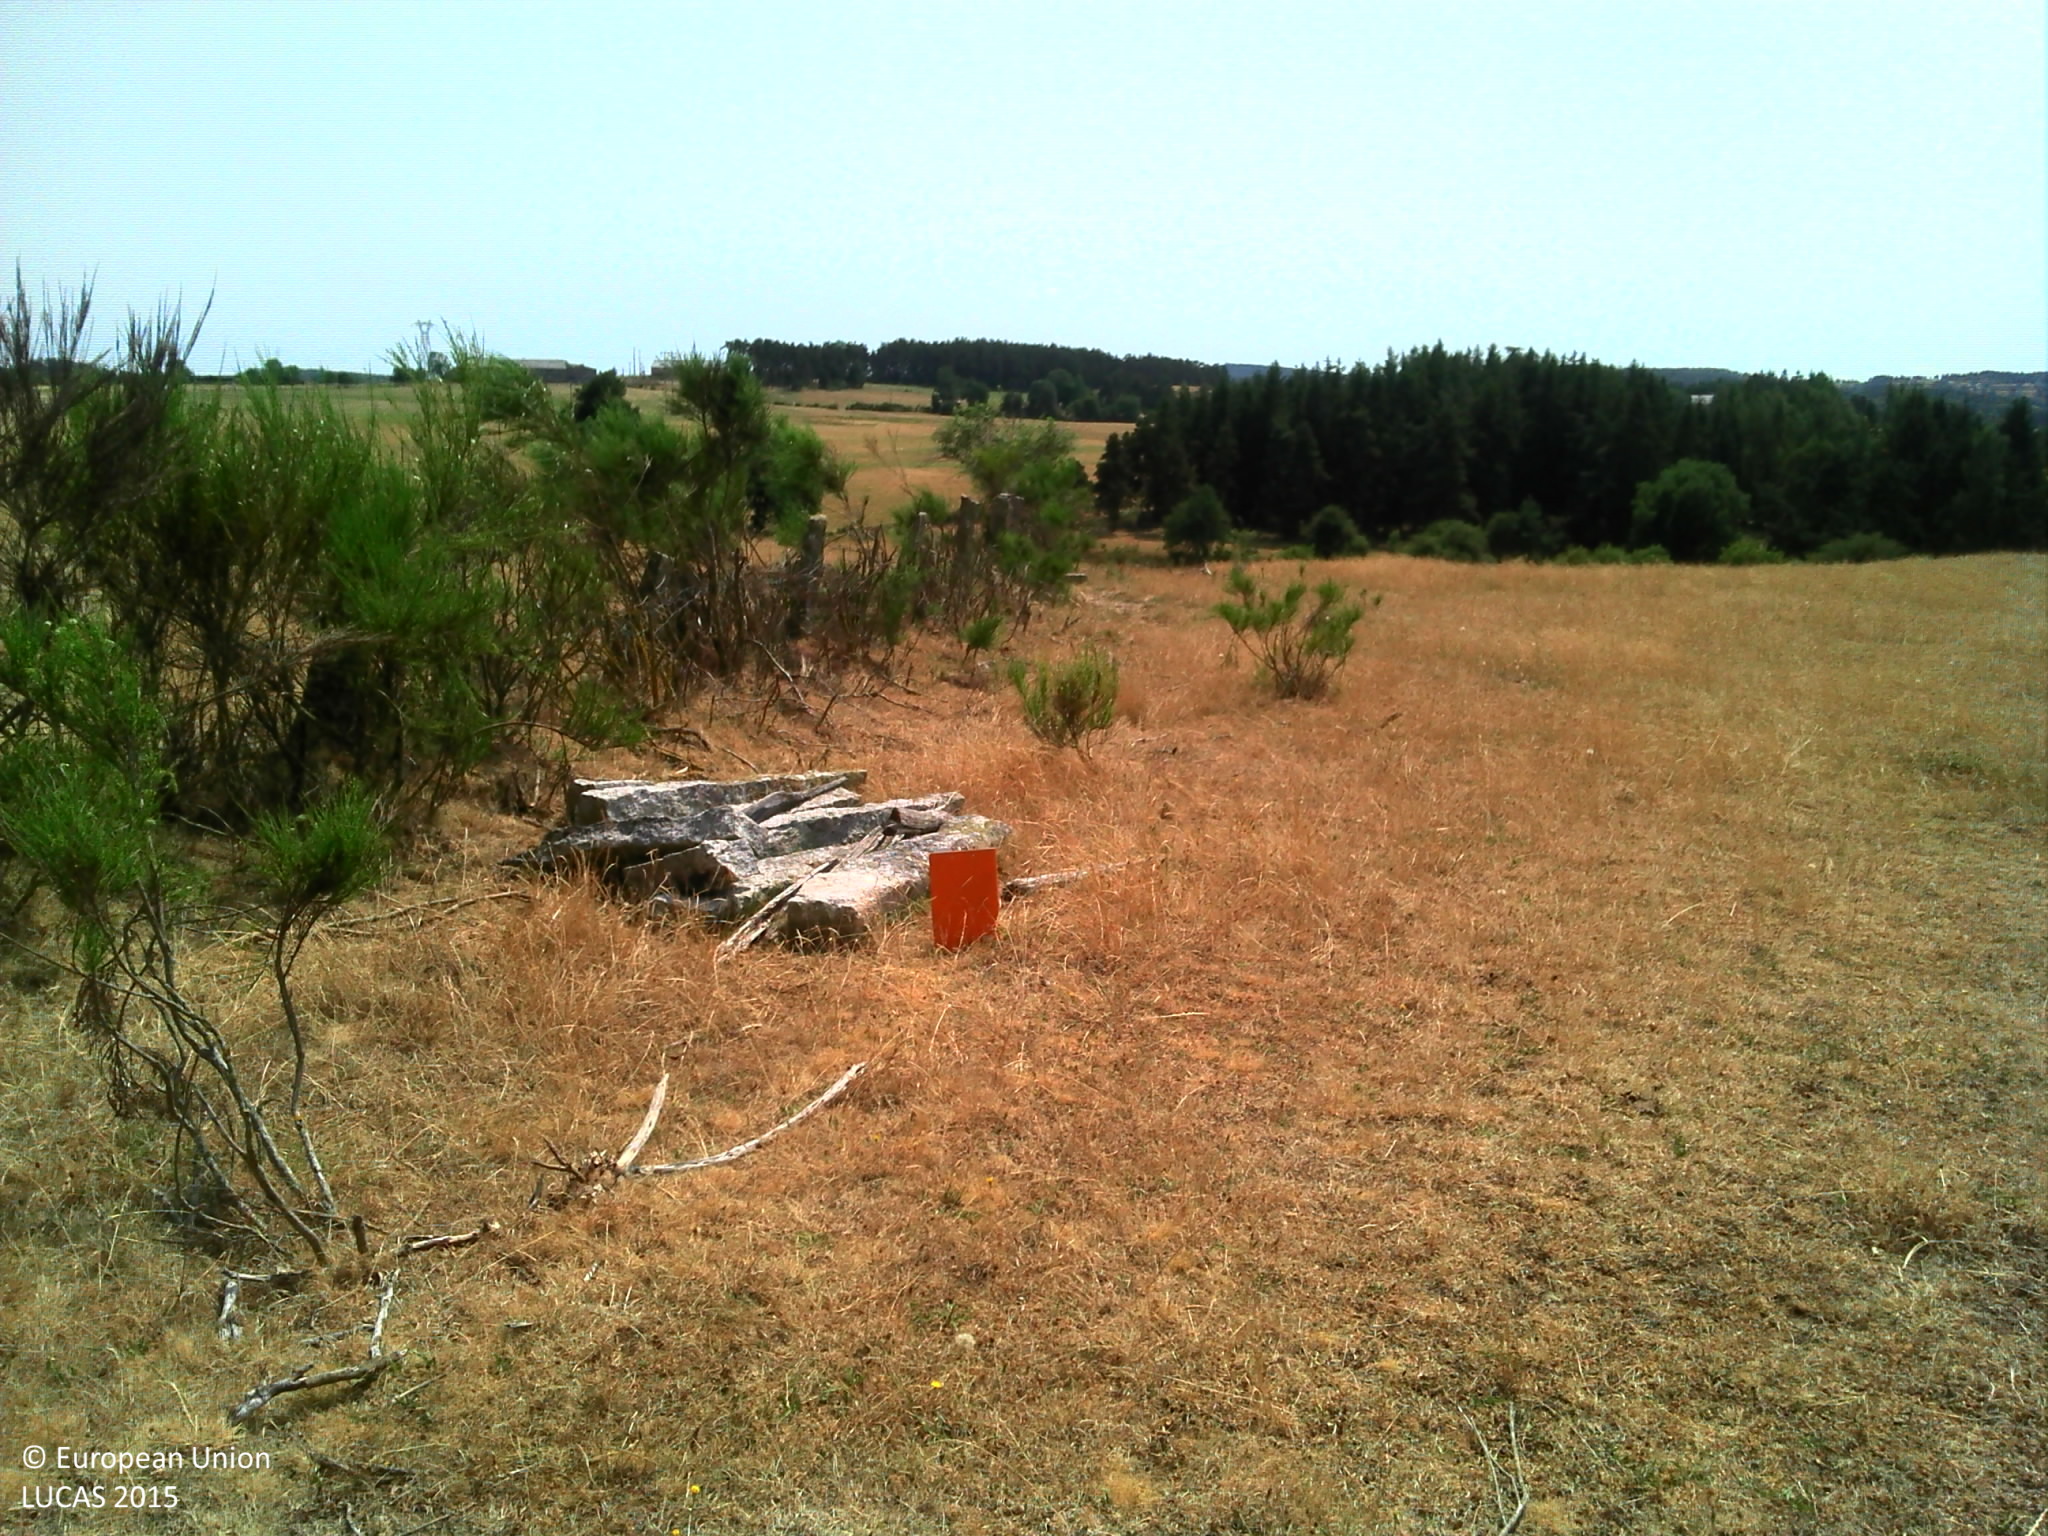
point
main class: Grassland
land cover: Grassland without tree/shrub cover
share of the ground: > 75 %
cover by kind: herbaceous plants 100 %
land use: Agriculture (excluding fallow land and kitchen gardens)
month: July
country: FR
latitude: 44.9071
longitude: 3.2271
